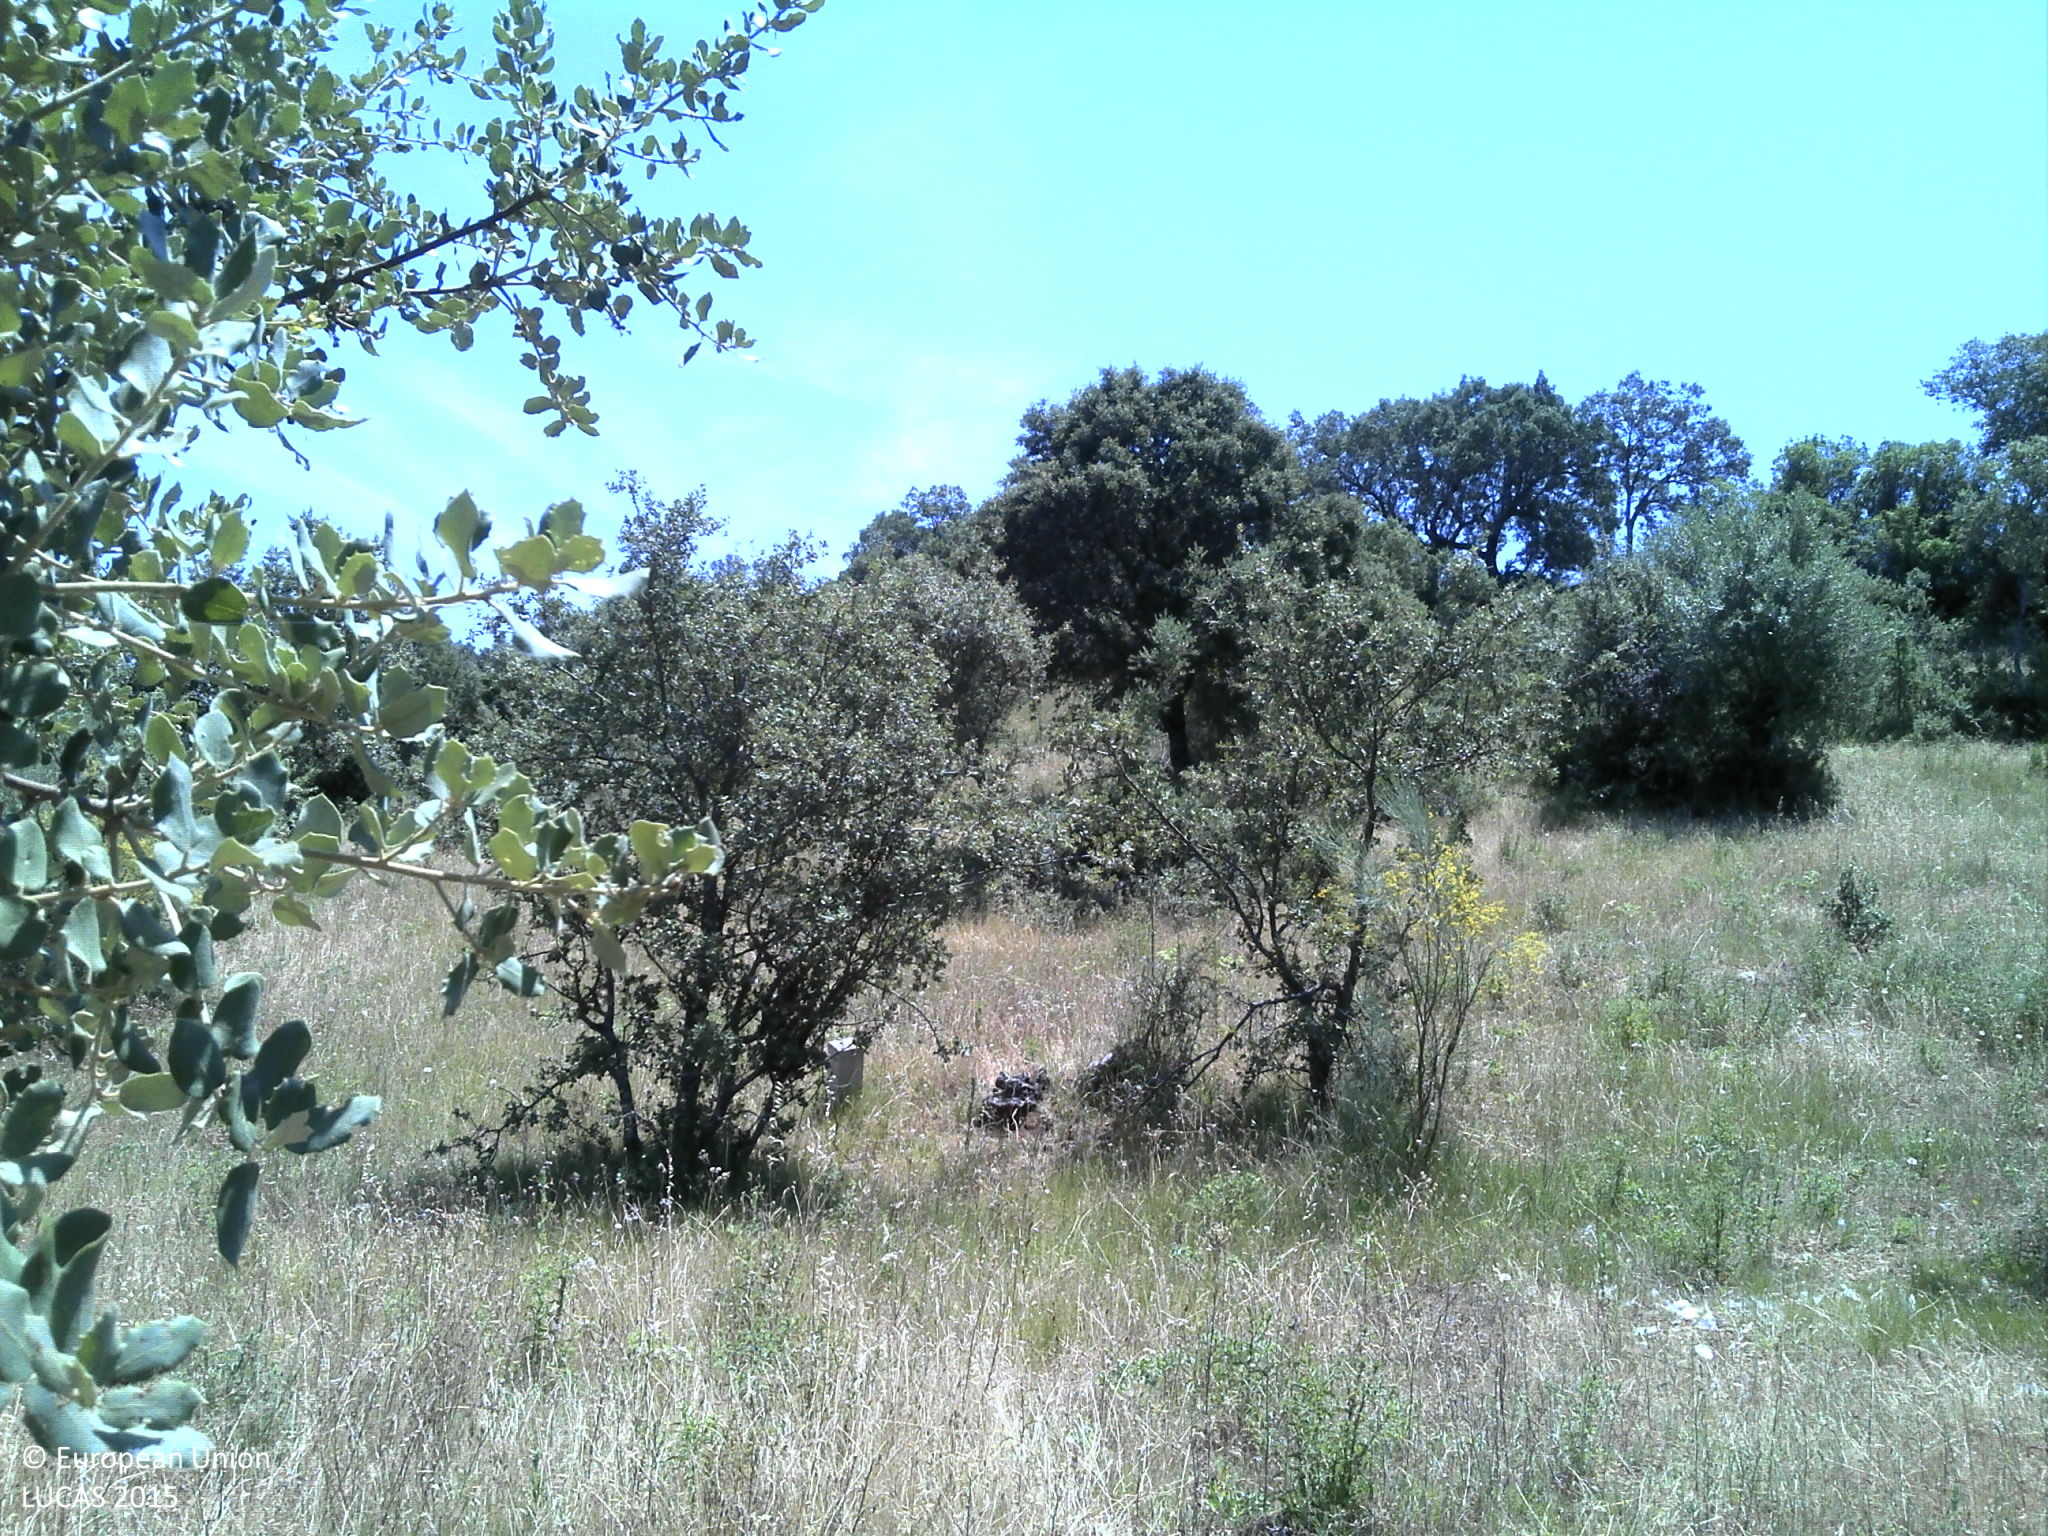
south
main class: Woodland
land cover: Broadleaved woodland
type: broadleaved evergreen forest
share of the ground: 10 - 25 %
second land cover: Grassland without tree/shrub cover
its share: 50 - 75 %
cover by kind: herbaceous plants 75 %, broadleaved forest trees 15 %, unconsolidated bare surface 10 %
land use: Forestry
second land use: Agriculture (excluding fallow land and kitchen gardens)
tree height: < 5 m
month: June
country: PT
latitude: 38.6432
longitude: -8.1893
